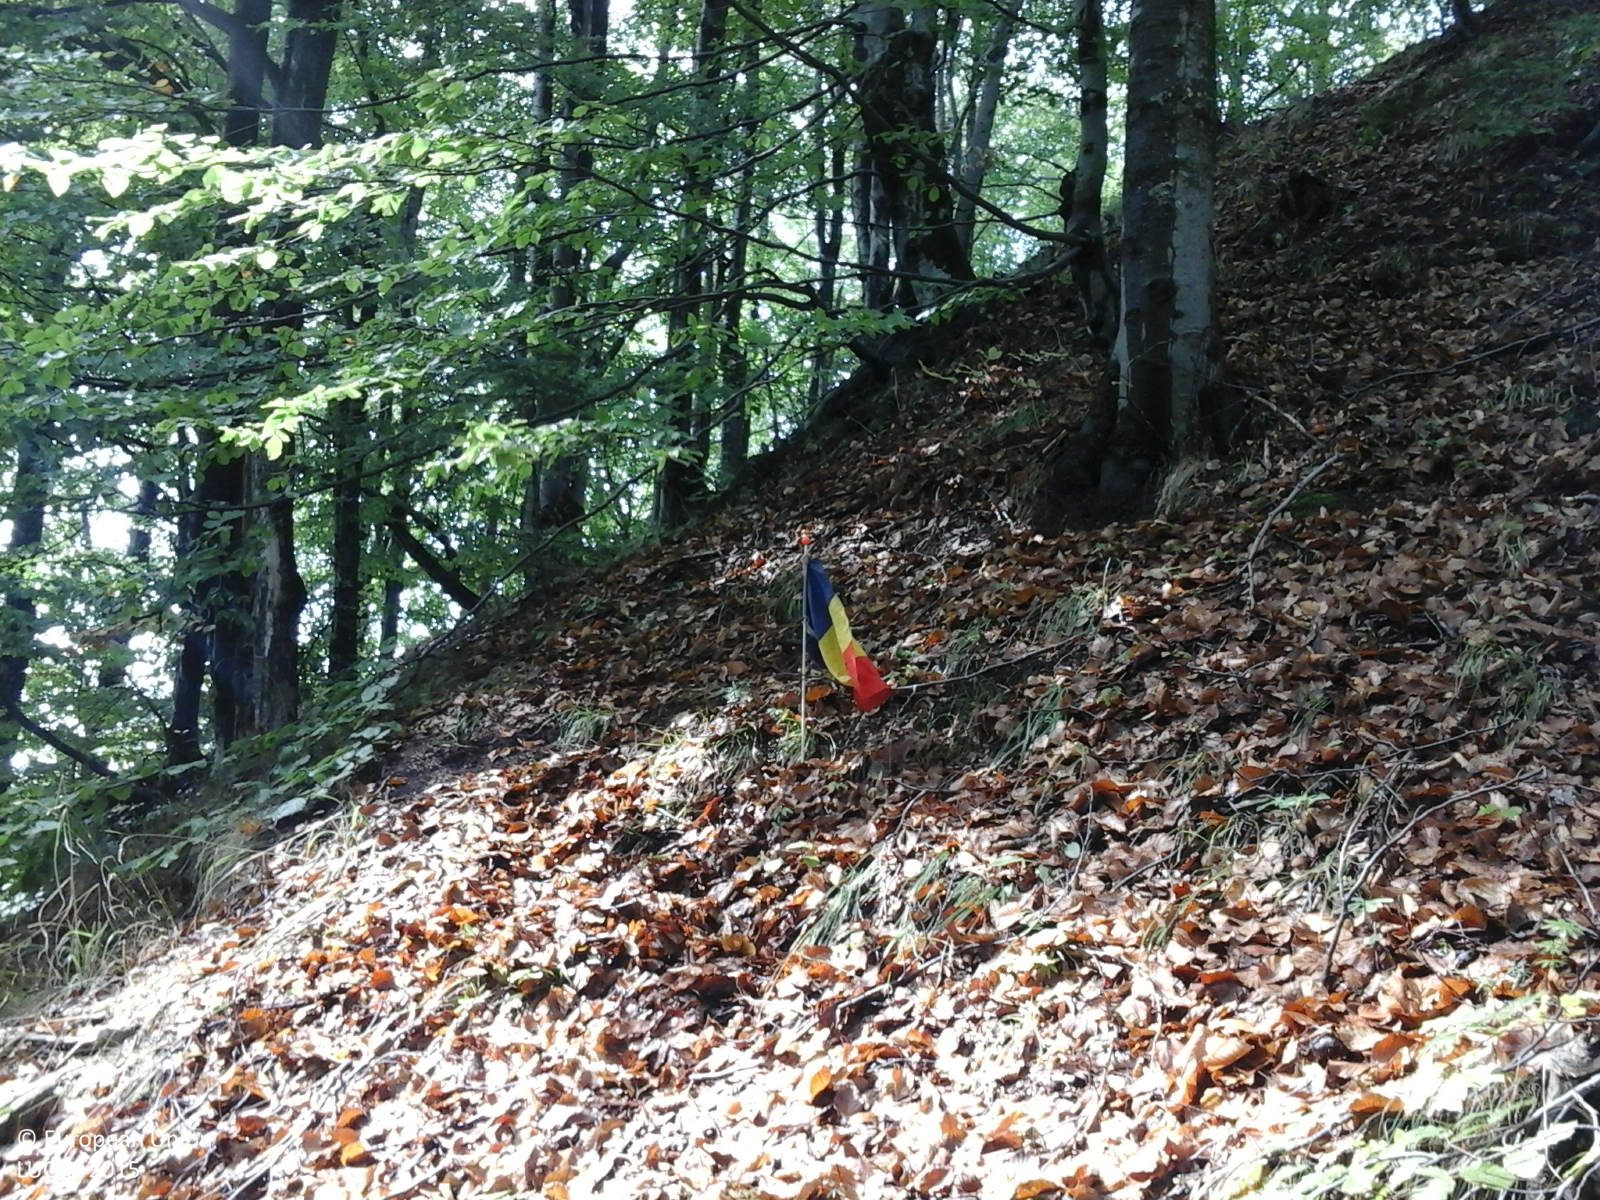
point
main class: Woodland
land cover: Broadleaved woodland
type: beech forest
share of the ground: > 75 %
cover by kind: broadleaved forest trees 100 %
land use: Forestry
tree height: > 5 m
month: September
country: RO
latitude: 45.2612
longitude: 23.2968
